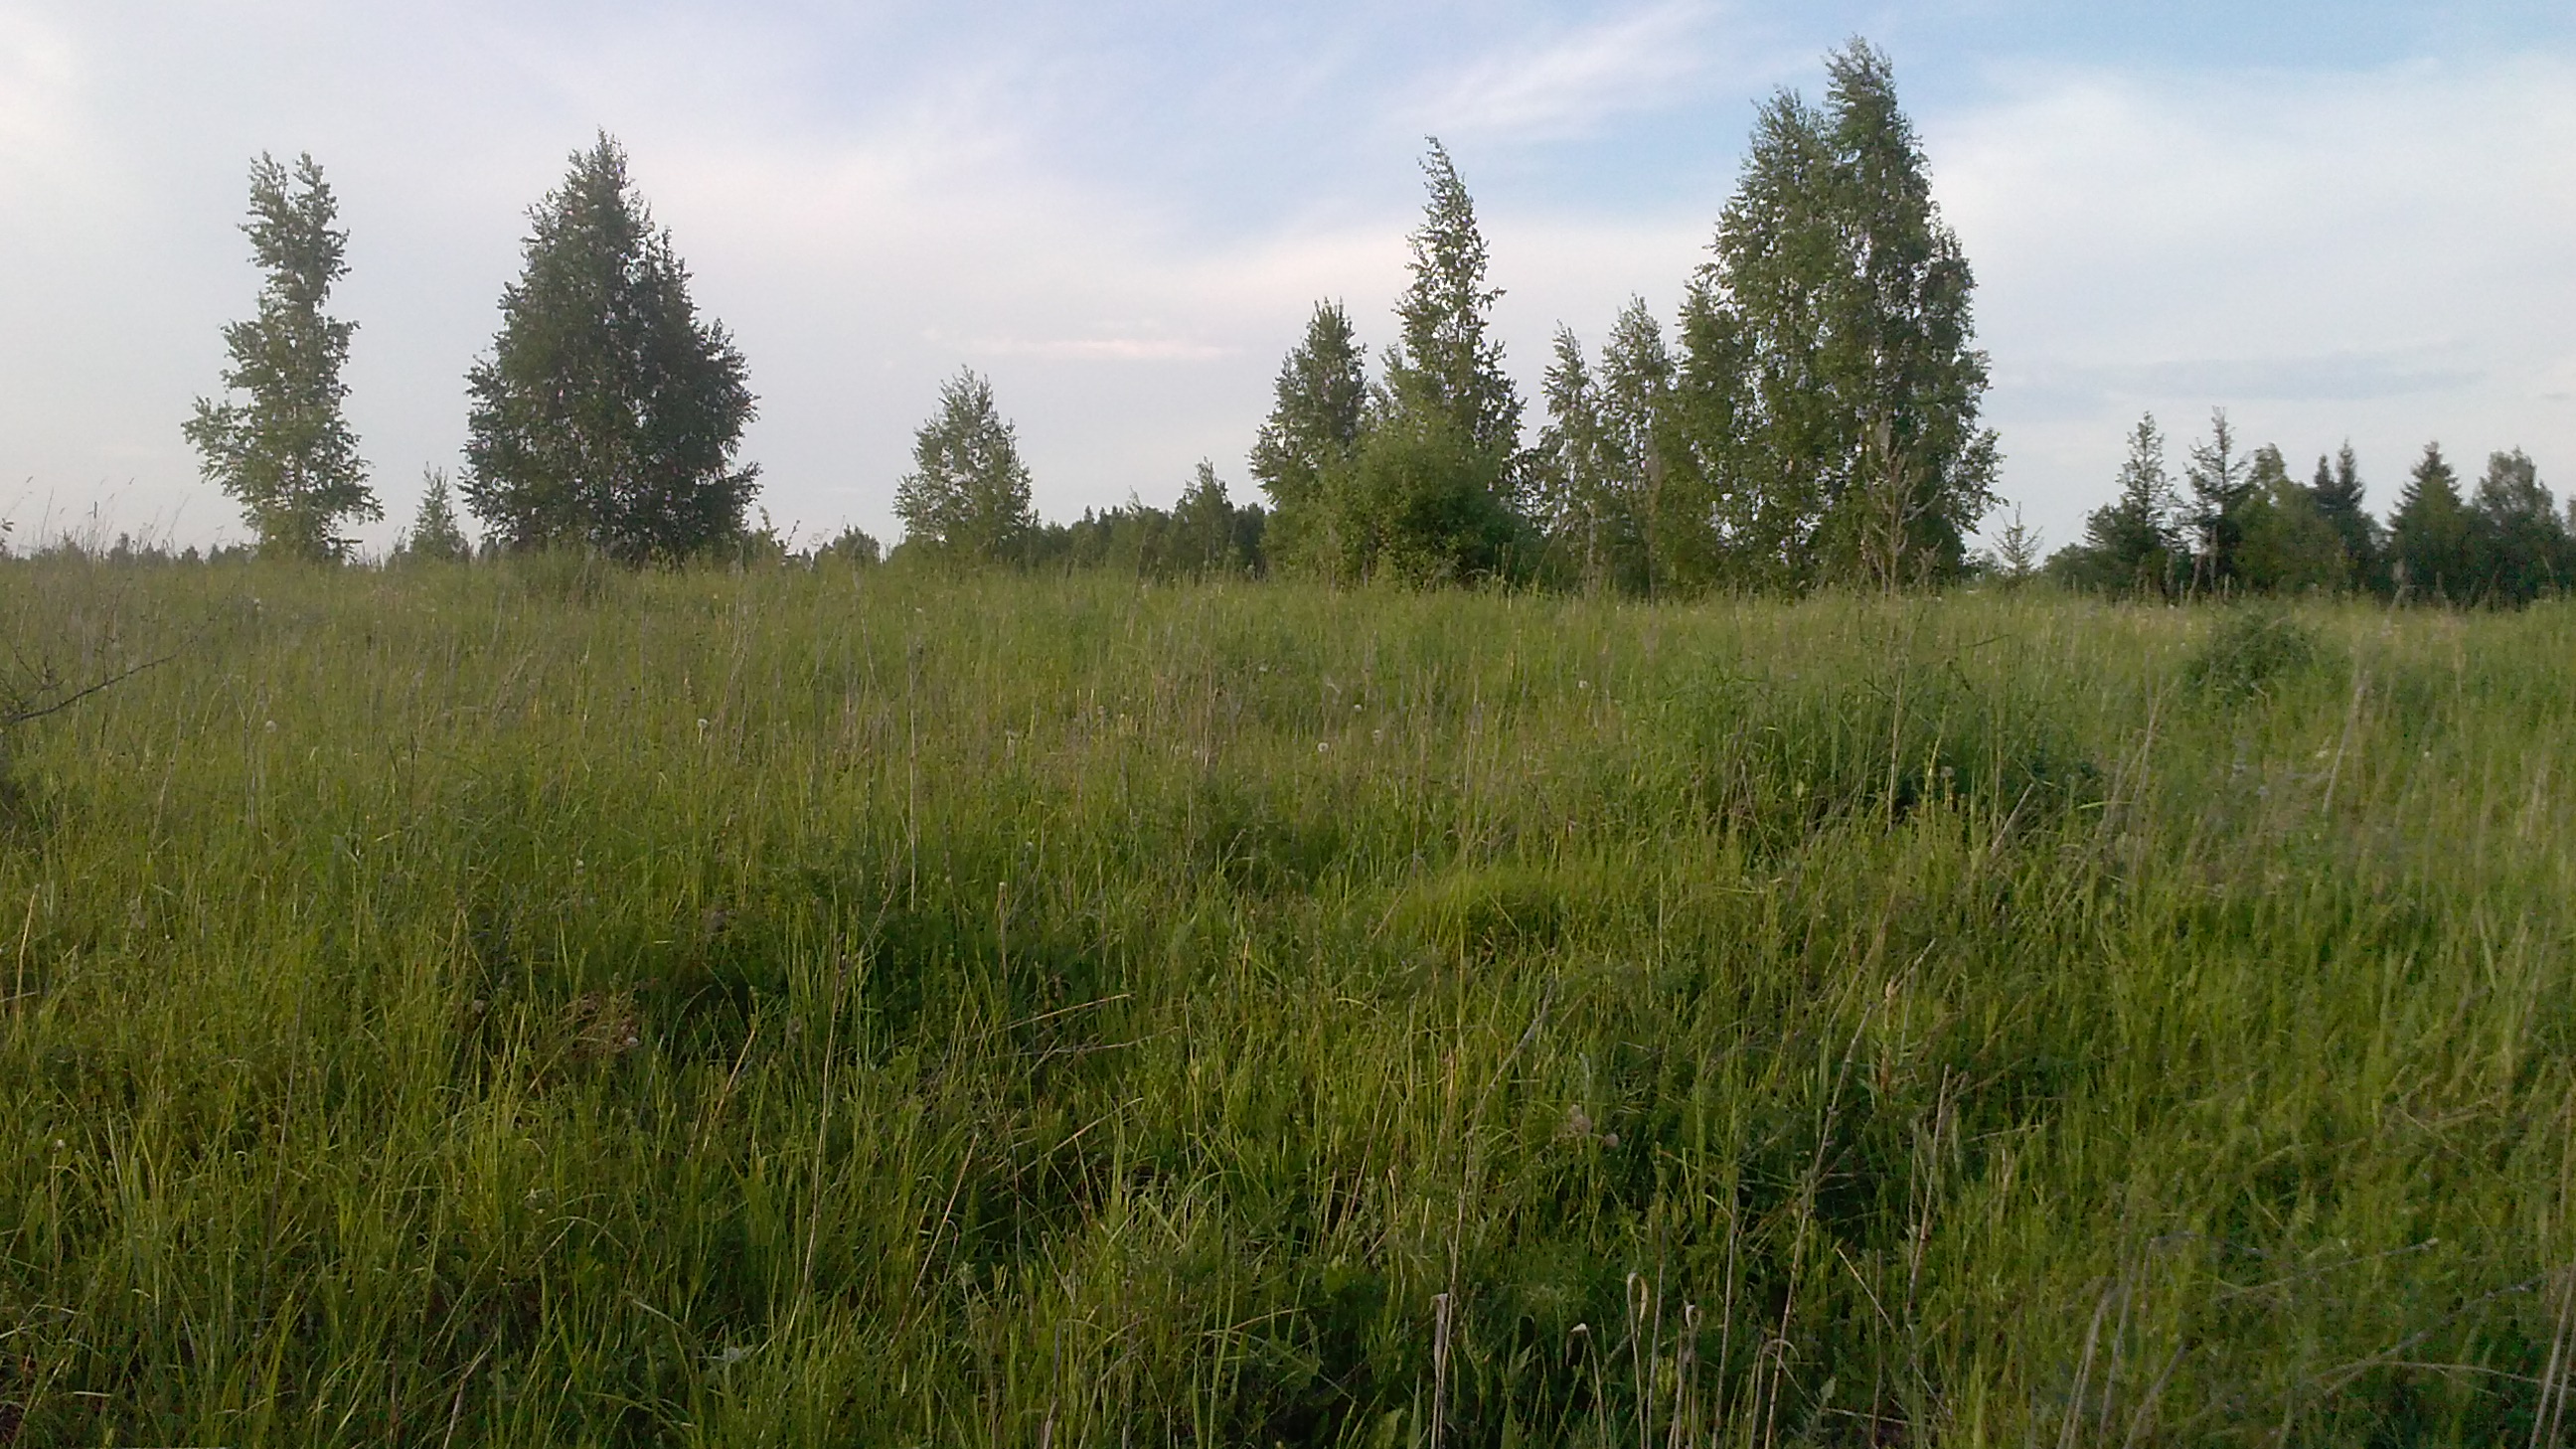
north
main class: Grassland
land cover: Grassland with sparse tree/shrub cover
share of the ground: > 75 %
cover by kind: herbaceous plants 95 %, broadleaved forest trees 5 %
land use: Agriculture (excluding fallow land and kitchen gardens)
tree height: > 5 m
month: June
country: LV
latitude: 56.3479
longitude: 27.9454
